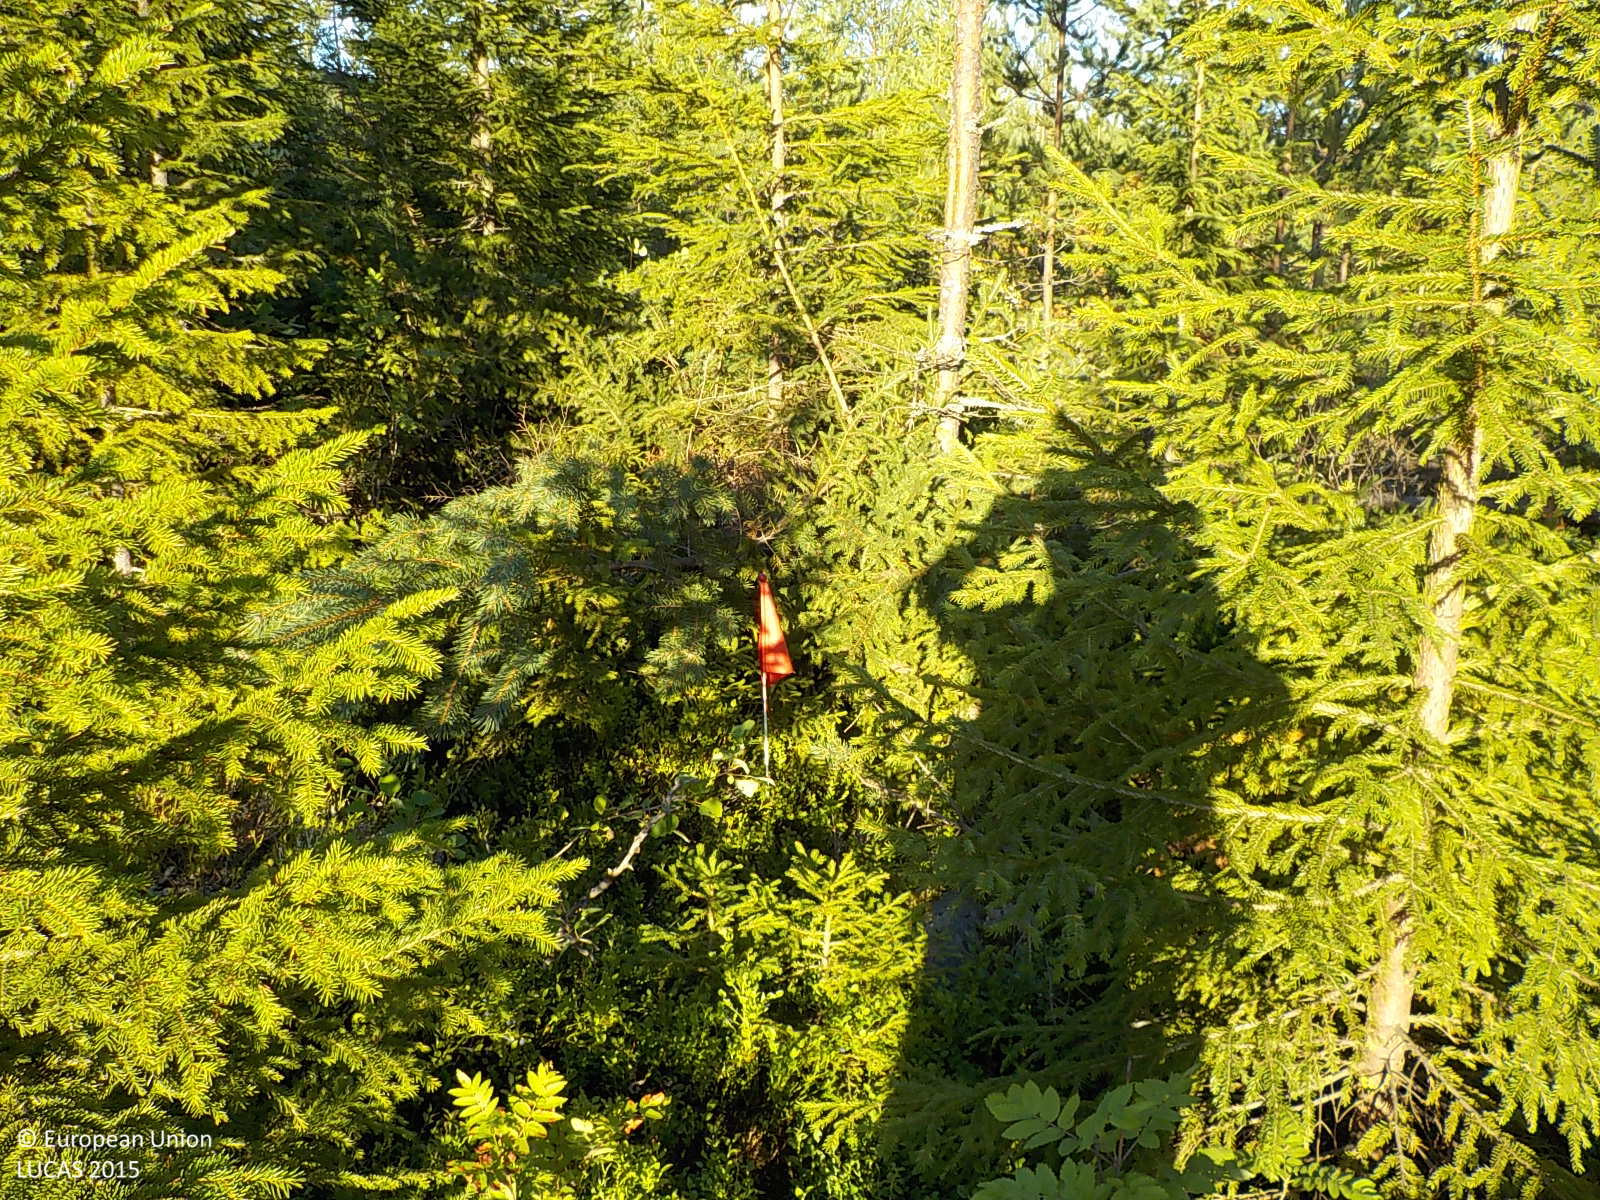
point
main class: Woodland
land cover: Other coniferous woodland
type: boreal forest
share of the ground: > 75 %
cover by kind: coniferous forest trees 80 %, shrubs 15 %, broadleaved forest trees 5 %
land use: Forestry
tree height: > 5 m
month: August
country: SE
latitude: 63.4078
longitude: 18.8080
